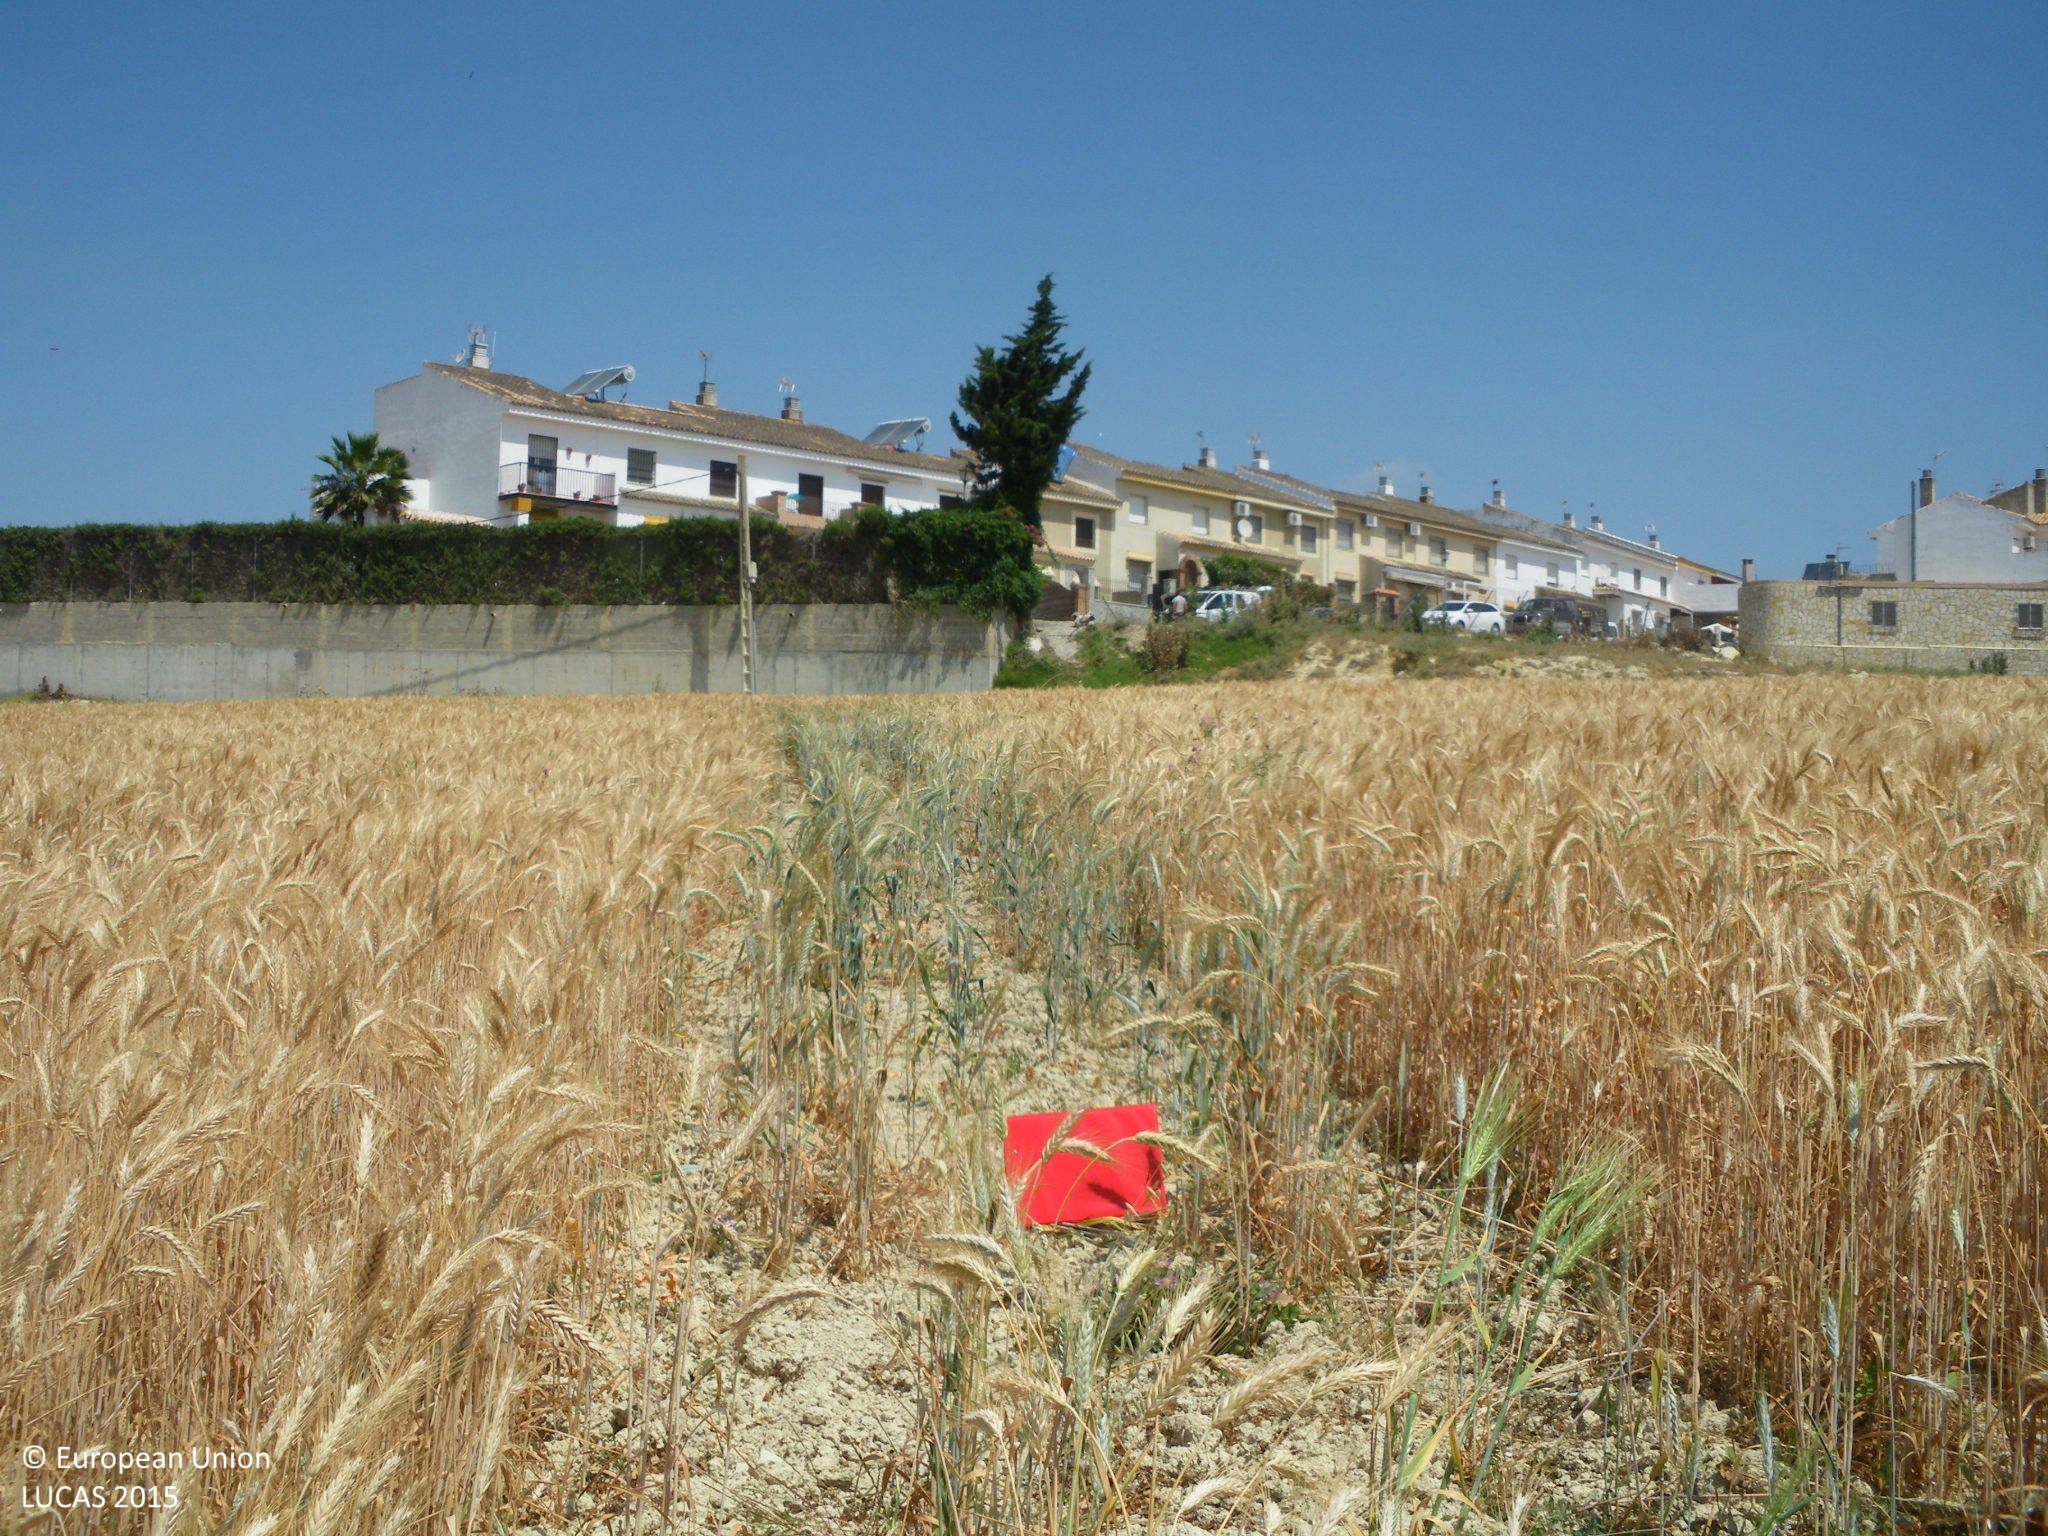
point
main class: Cropland
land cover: Triticale
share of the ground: 10 - 25 %
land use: Agriculture (excluding fallow land and kitchen gardens)
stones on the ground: < 10 %
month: May
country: ES
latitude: 36.8683
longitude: -6.1814
